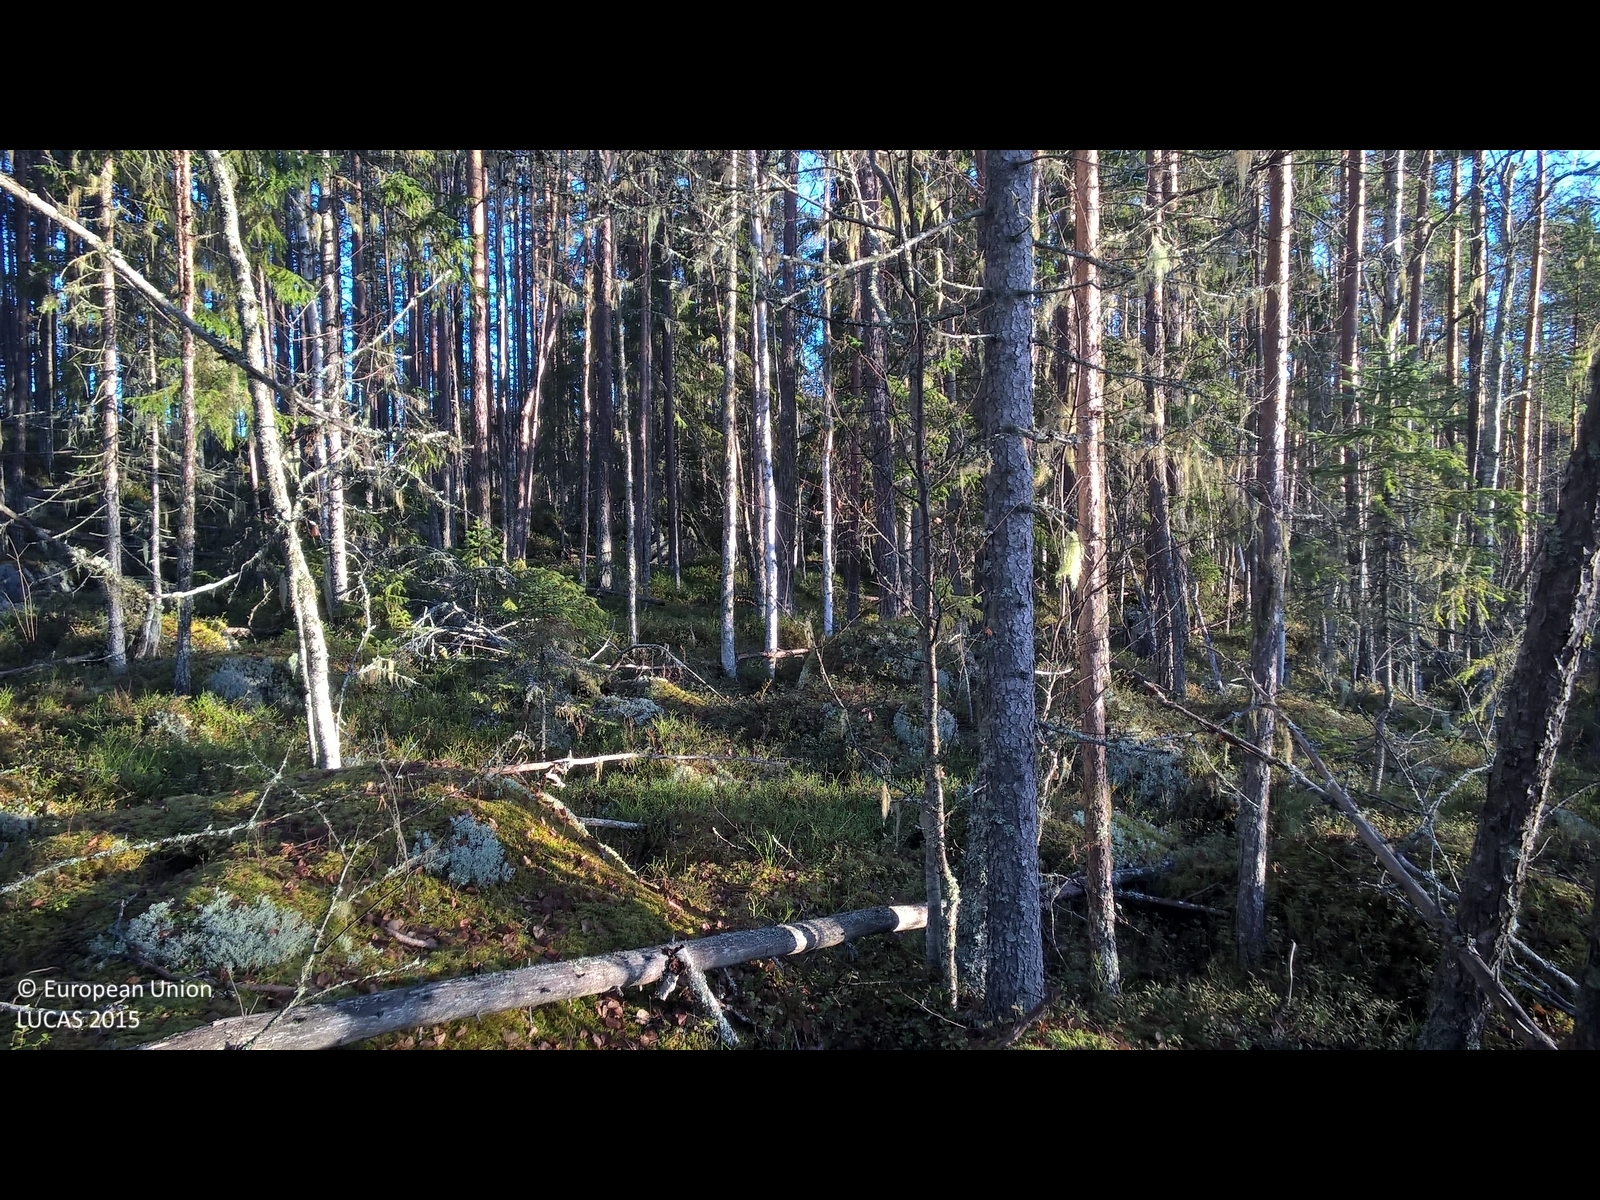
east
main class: Woodland
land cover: Pine dominated coniferous woodland
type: boreal forest
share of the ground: > 75 %
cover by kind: coniferous forest trees 75 %, lichens and mosses 20 %, broadleaved forest trees 5 %
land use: Forestry
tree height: > 5 m
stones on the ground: < 10 %
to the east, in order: Pine dominated coniferous woodland; Peatbogs; Pine dominated coniferous woodland
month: November
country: SE
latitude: 62.4378
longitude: 15.0369
